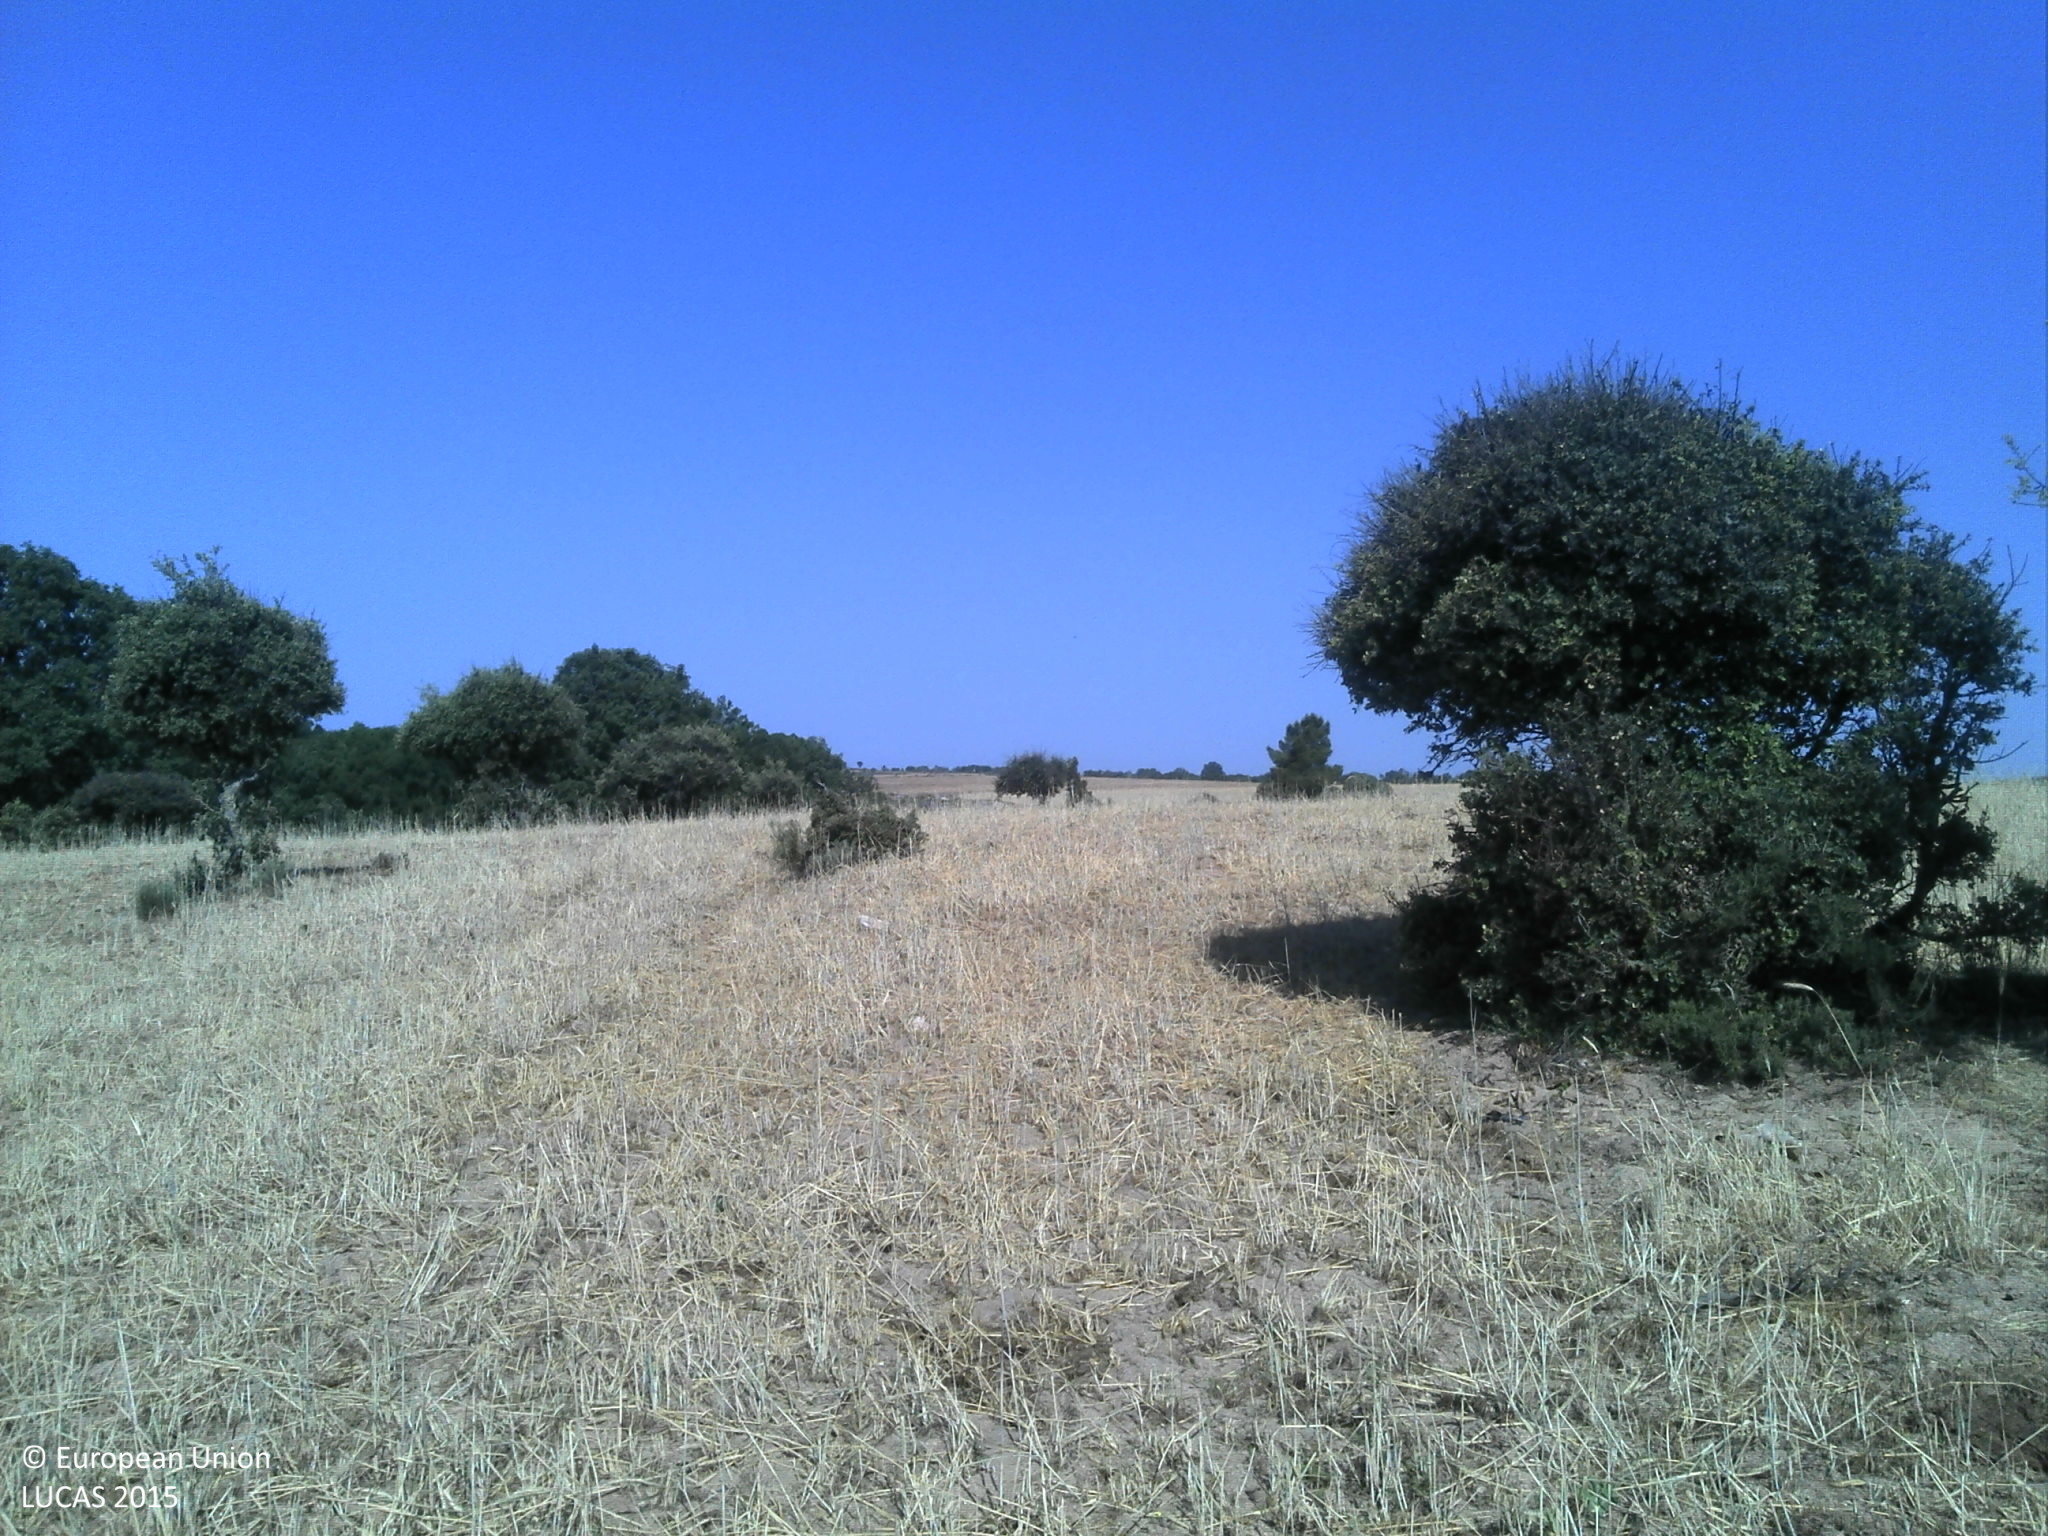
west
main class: Grassland
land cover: Grassland with sparse tree/shrub cover
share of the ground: 10 - 25 %
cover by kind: unconsolidated bare surface 85 %, herbaceous plants 10 %, broadleaved forest trees 5 %
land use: Agriculture (excluding fallow land and kitchen gardens)
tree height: > 5 m
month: June
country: PT
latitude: 40.5662
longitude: -6.8569
